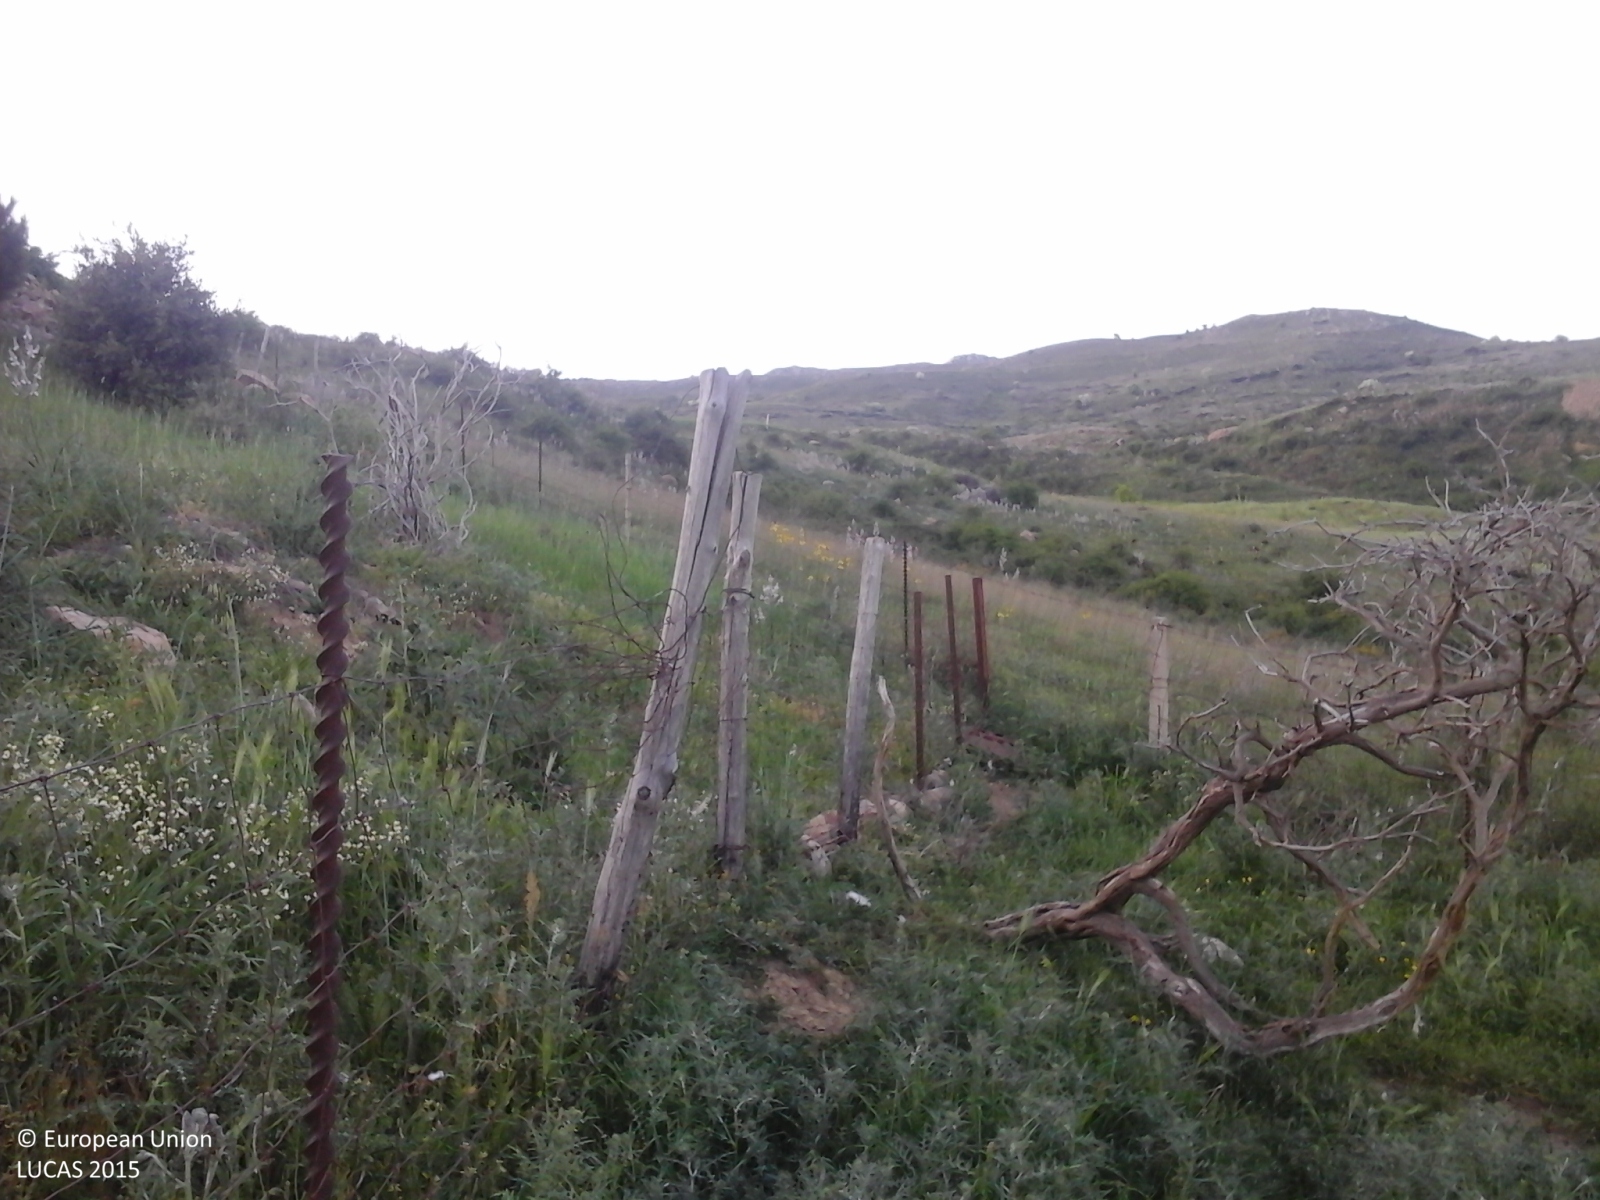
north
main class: Cropland
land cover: Pear fruit
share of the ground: 25 - 50 %
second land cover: Spontaneously vegetated surfaces
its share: > 75 %
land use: Agriculture (excluding fallow land and kitchen gardens)
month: May
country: IT
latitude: 37.8210
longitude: 14.1398
